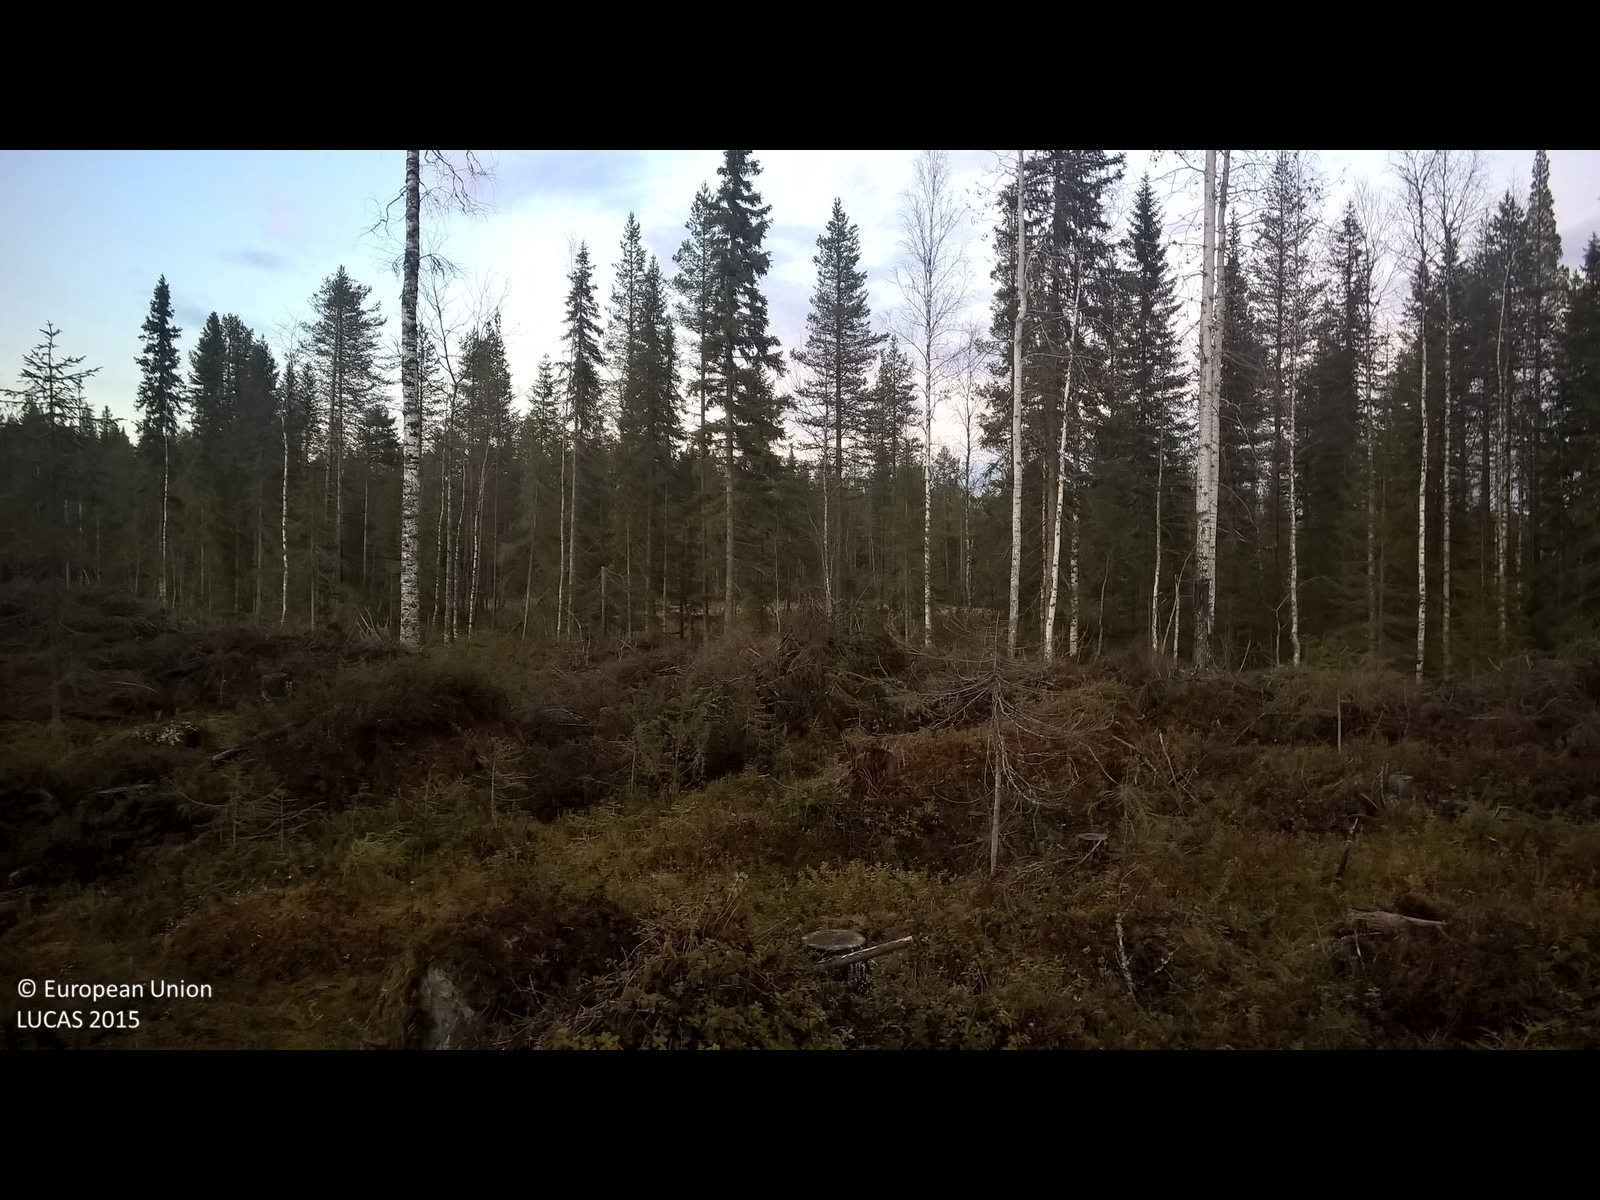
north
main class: Shrubland
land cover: Shrubland with sparse tree cover
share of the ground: > 75 %
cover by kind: shrubs 85 %, herbaceous plants 10 %, coniferous forest trees 5 %
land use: Forestry
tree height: < 5 m
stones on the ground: < 10 %
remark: Clear cut
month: October
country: SE
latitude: 65.1106
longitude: 18.2467
